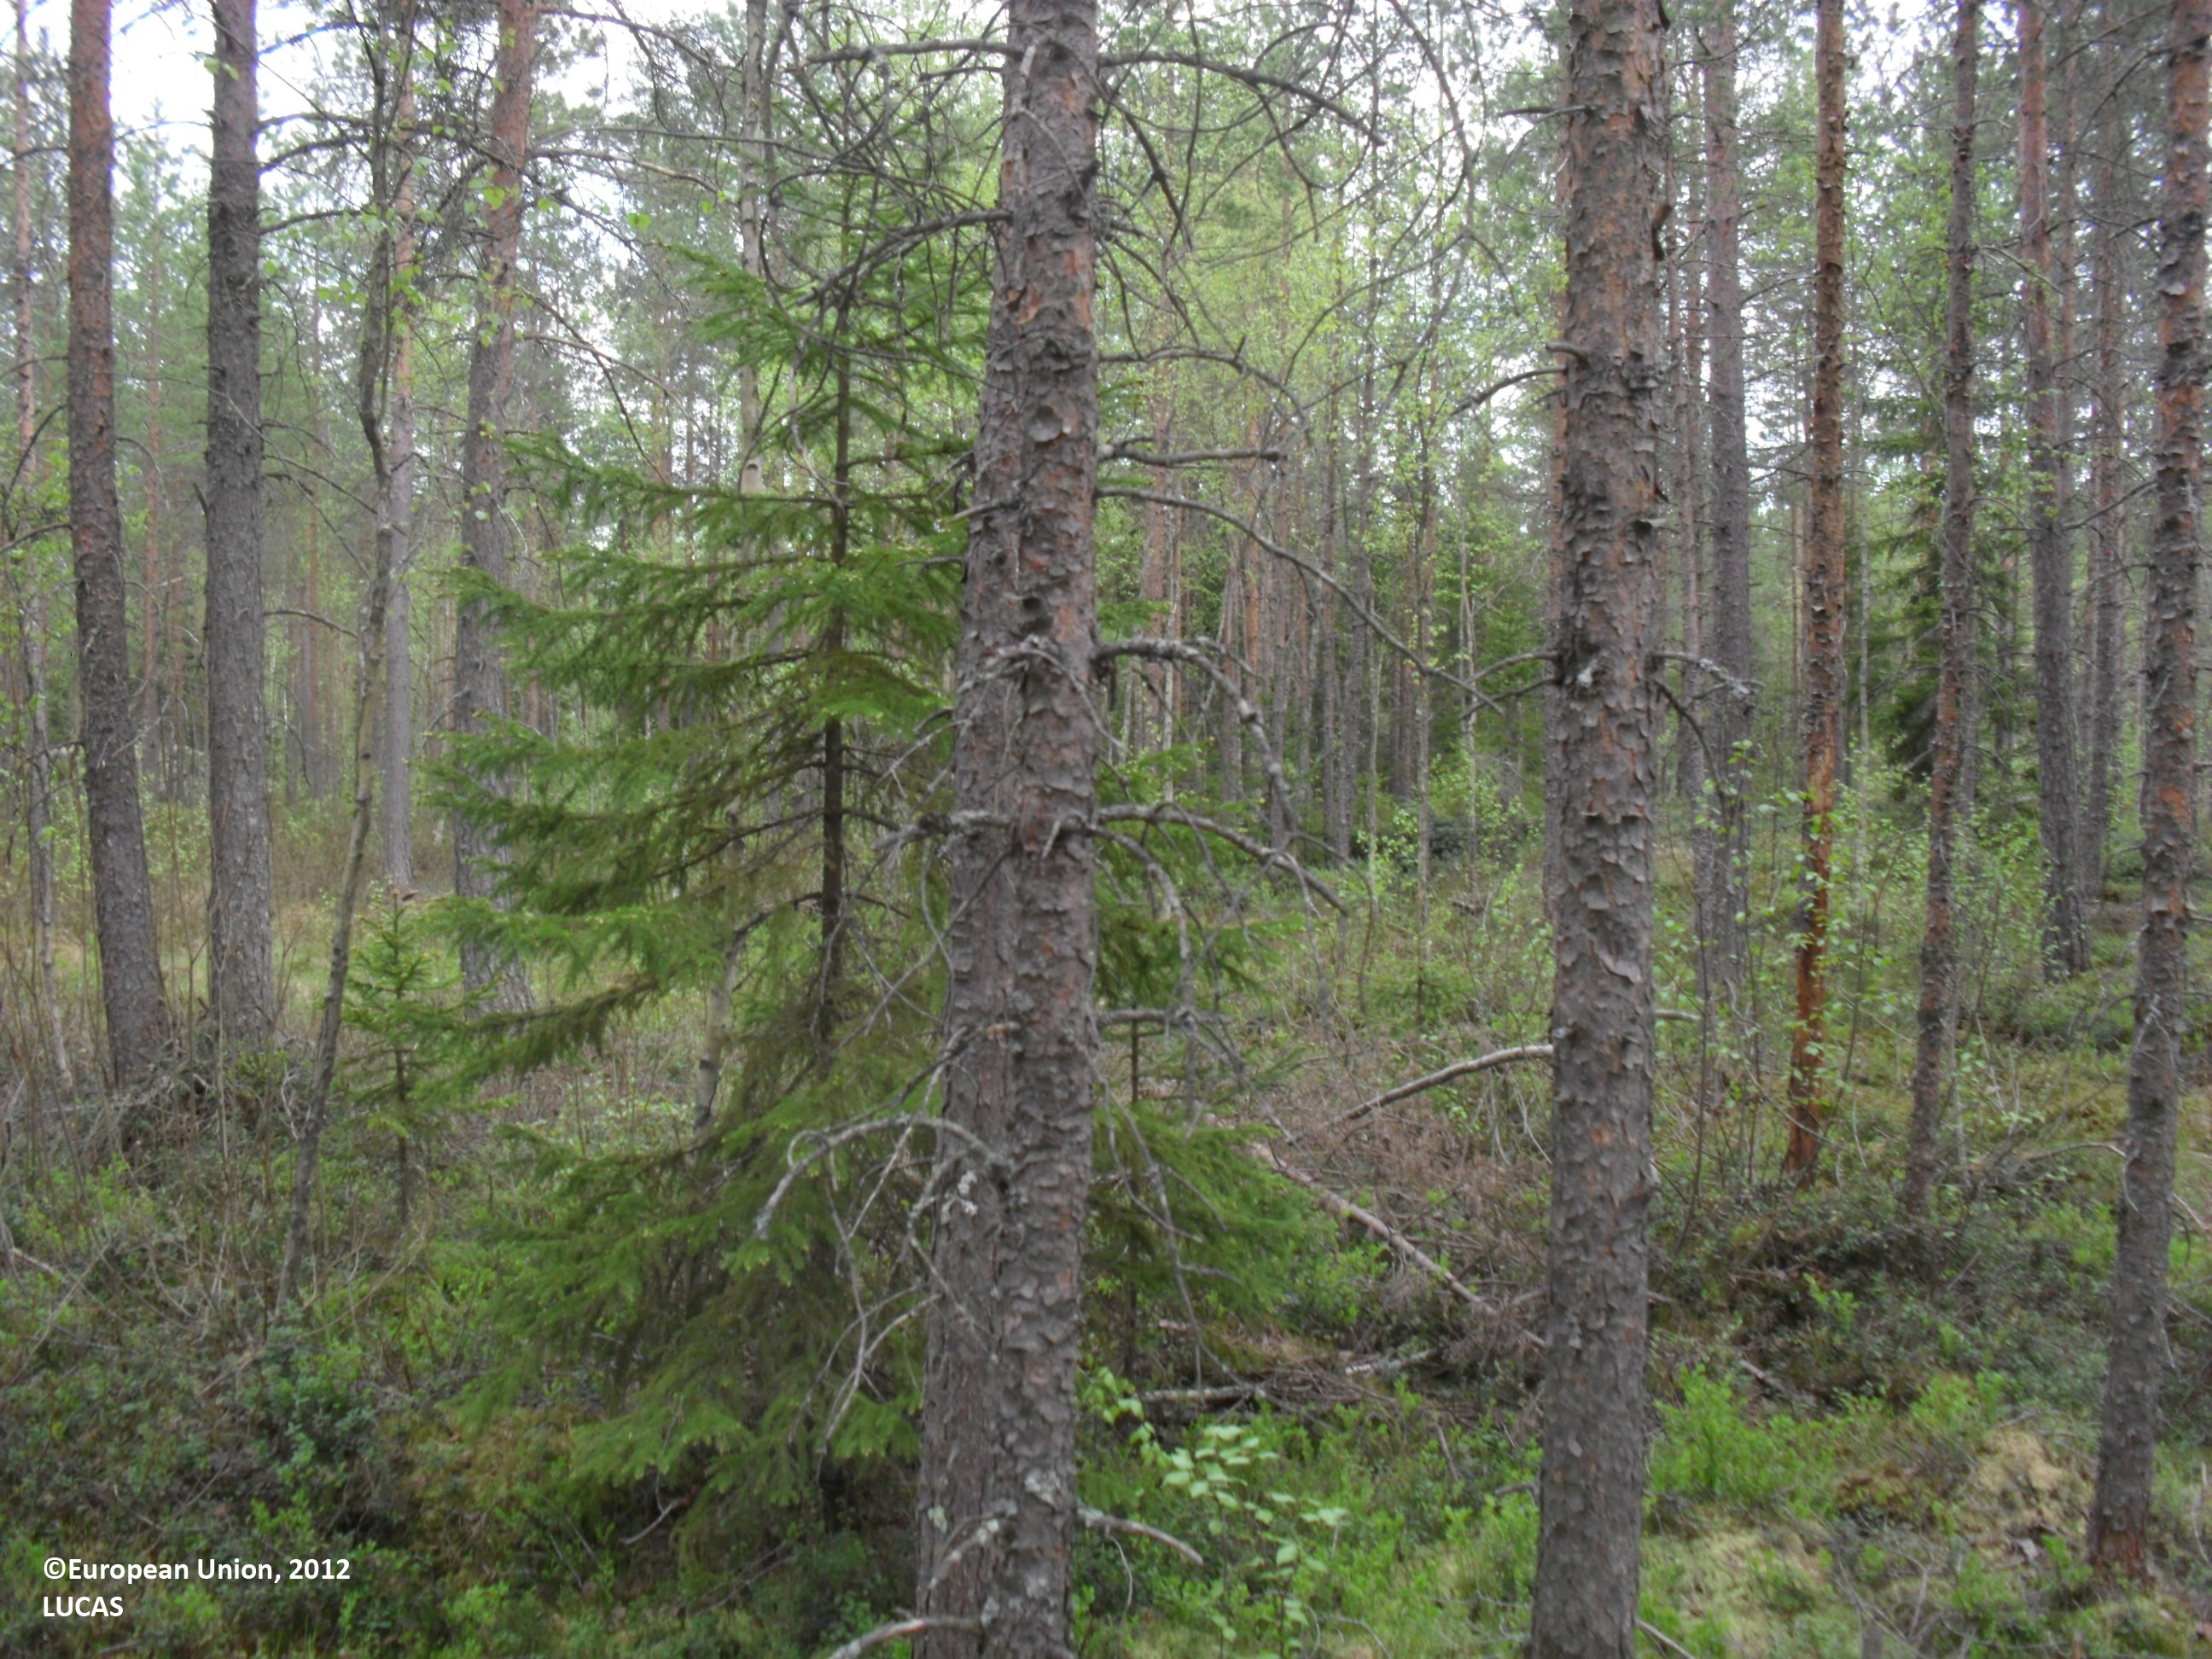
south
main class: Woodland
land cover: Pine dominated coniferous woodland
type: boreal forest
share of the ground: 50 - 75 %
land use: Forestry
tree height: > 5 m
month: May
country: FI
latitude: 63.2645
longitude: 23.1082
